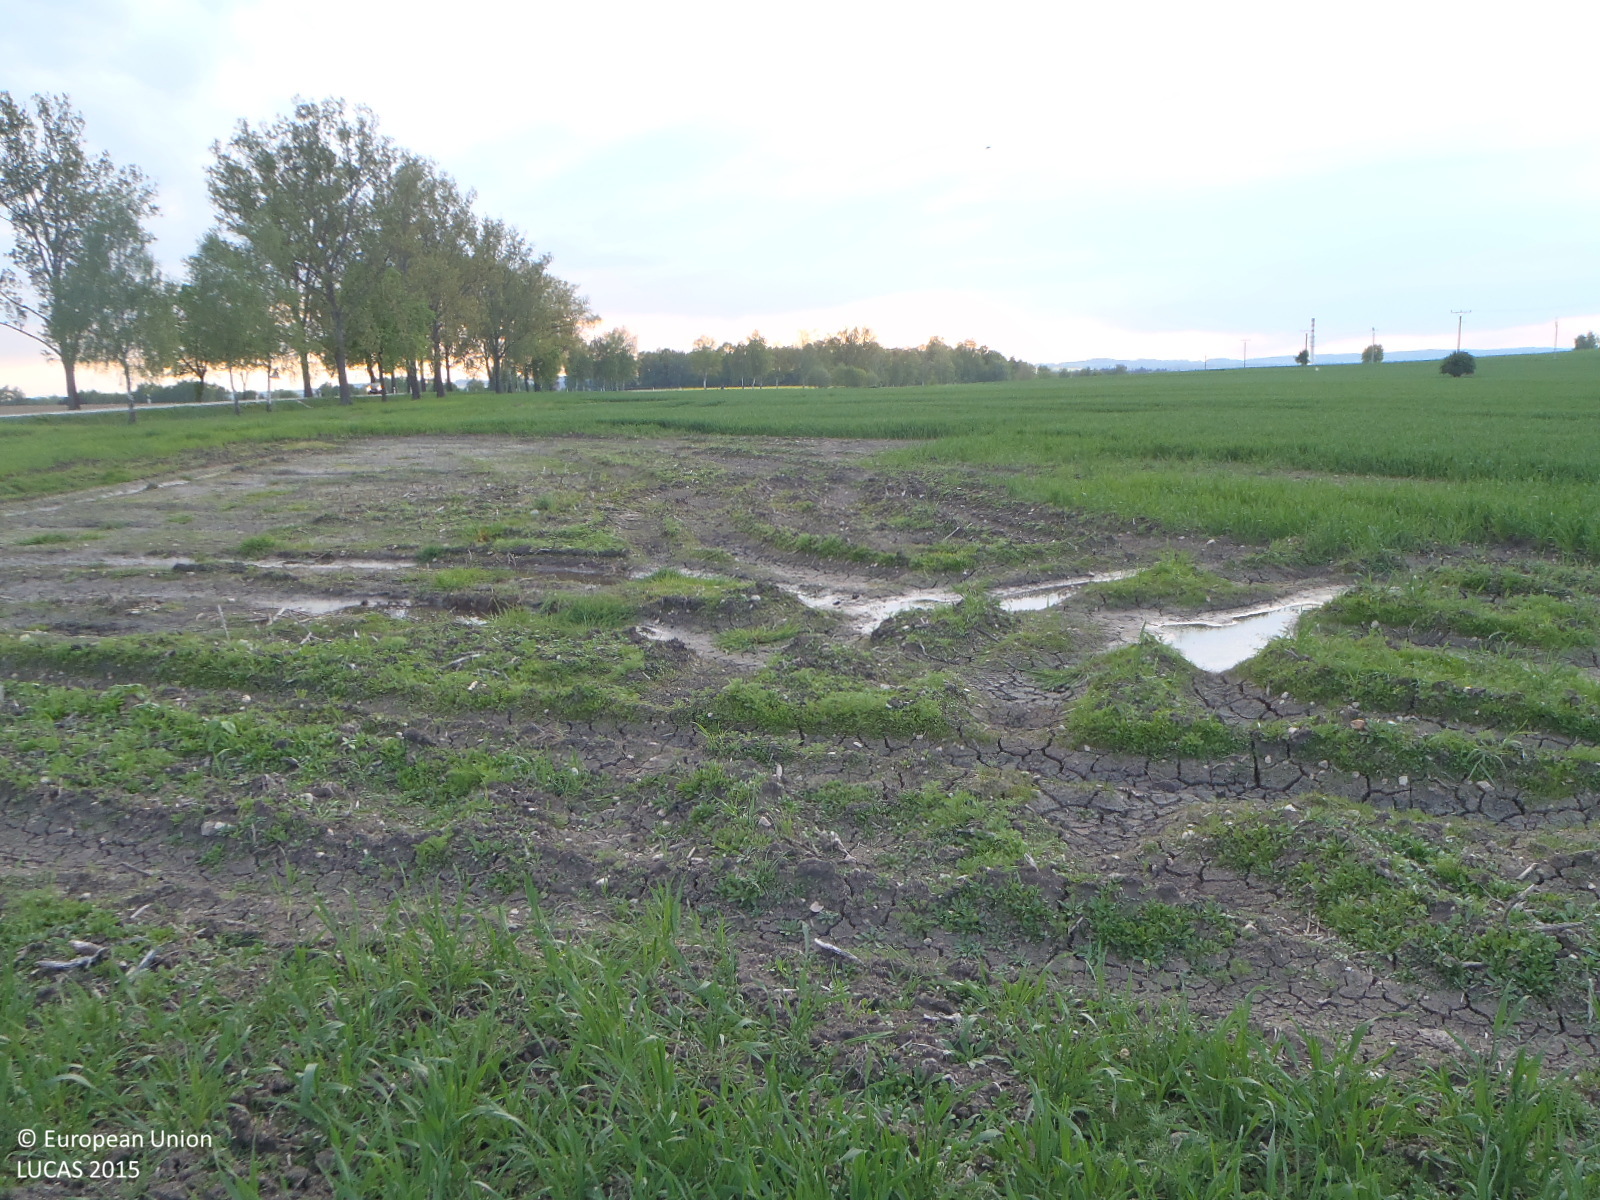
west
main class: Cropland
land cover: Triticale
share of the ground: 50 - 75 %
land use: Agriculture (excluding fallow land and kitchen gardens)
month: May
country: CZ
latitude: 49.1349
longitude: 15.0599
